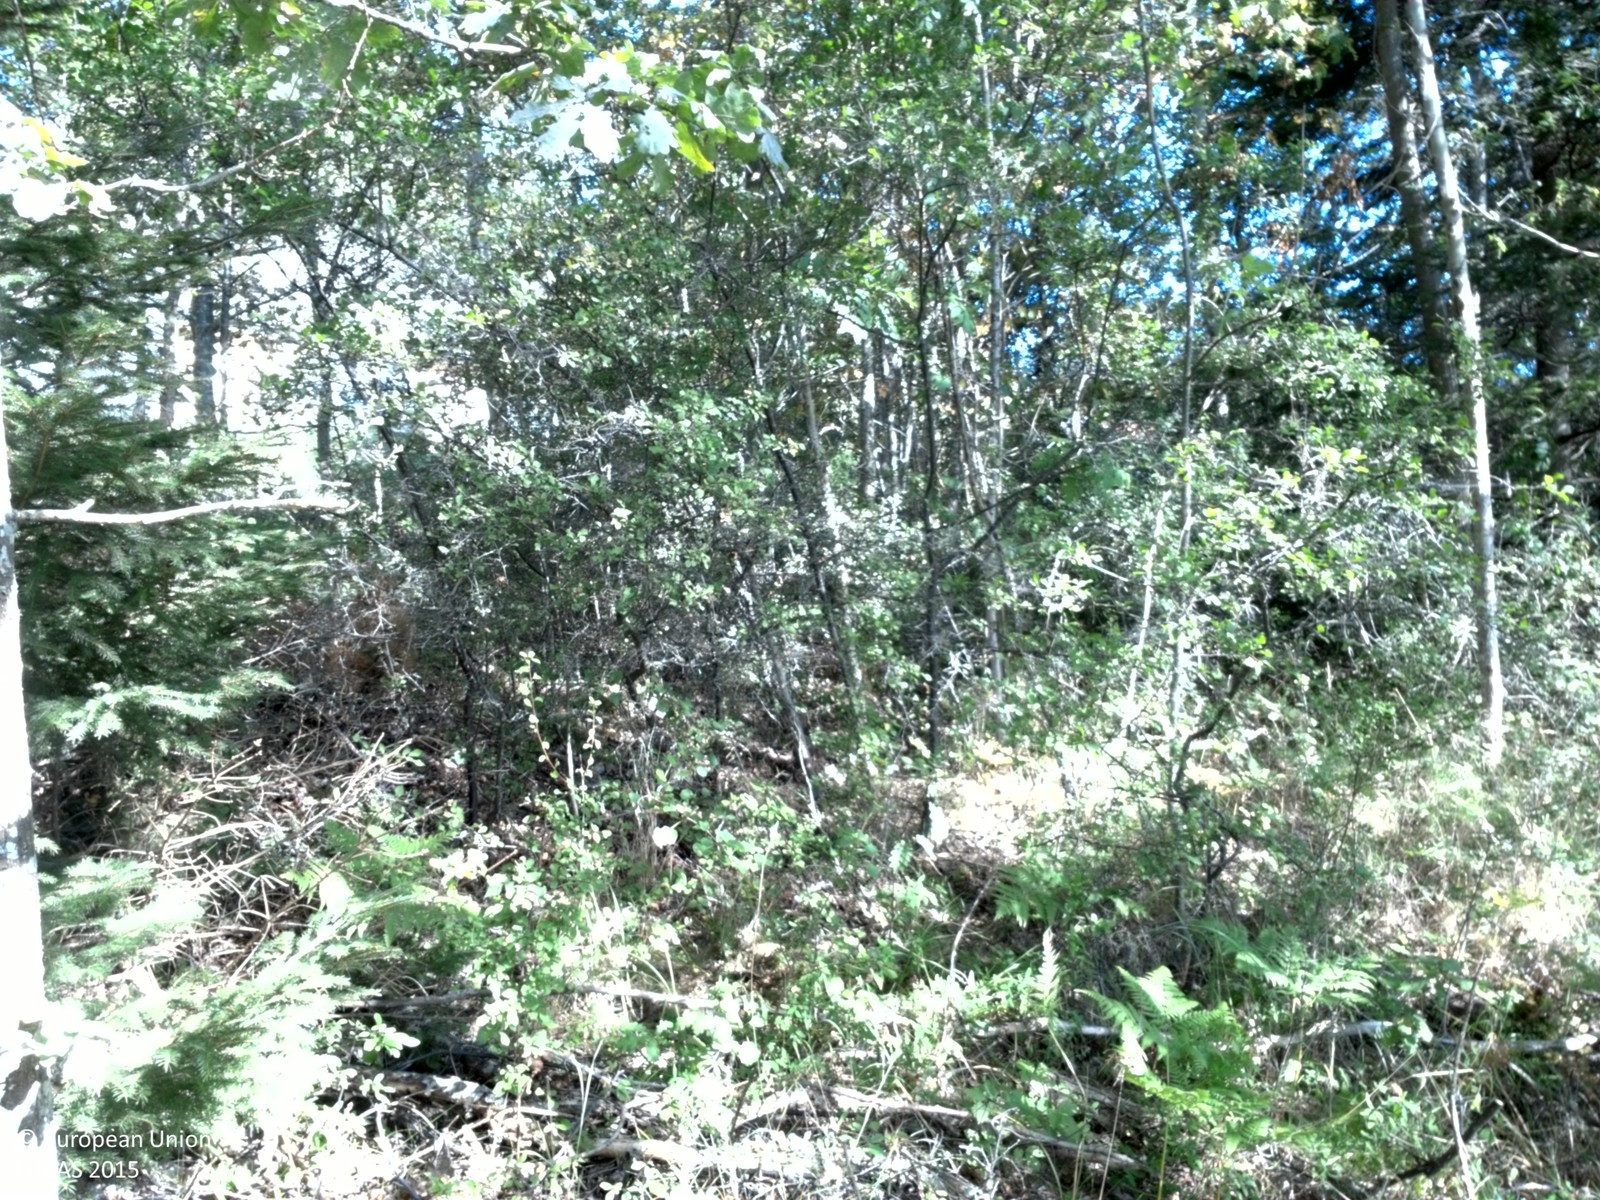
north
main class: Woodland
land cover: Broadleaved woodland
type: hemiboreal forest and nemoral coniferous forest and mixed broadleaved-coniferous forest
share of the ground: 50 - 75 %
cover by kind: broadleaved forest trees 65 %, herbaceous plants 30 %, coniferous forest trees 5 %
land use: Forestry
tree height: > 5 m
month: August
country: SE
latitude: 59.4689
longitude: 17.6023
